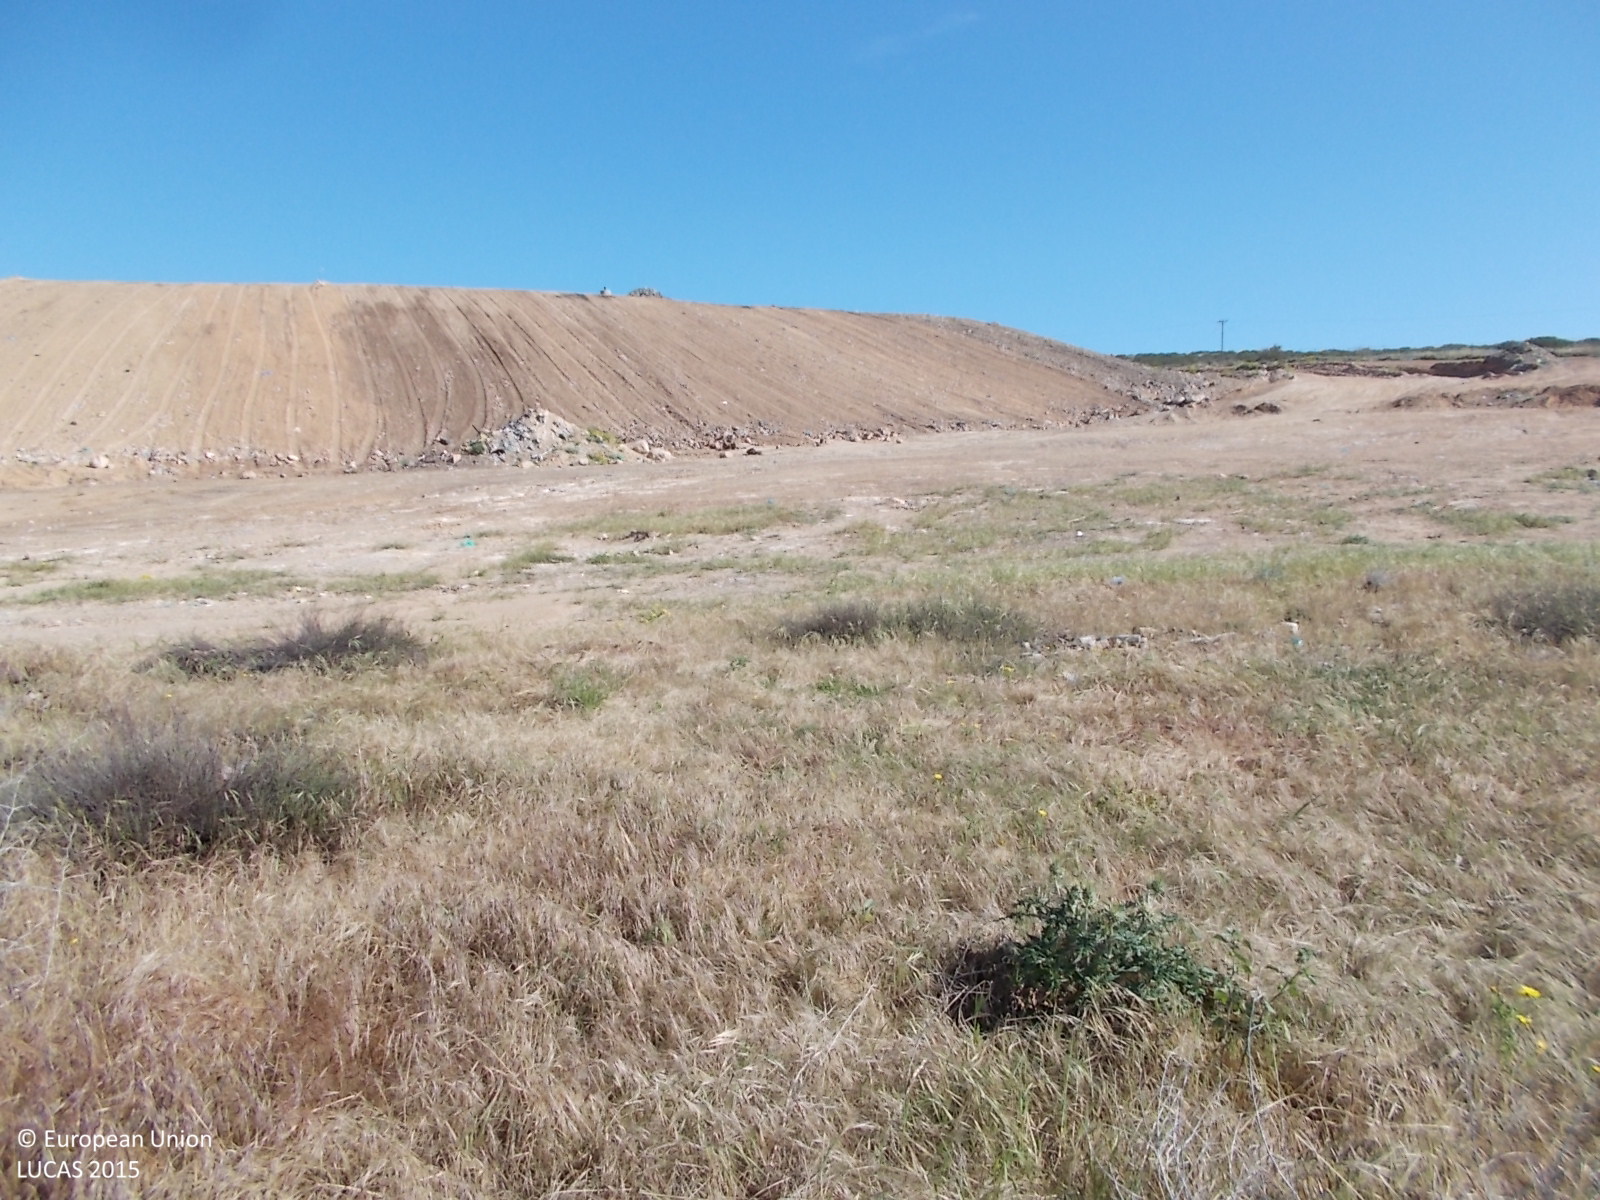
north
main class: Grassland
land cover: Grassland without tree/shrub cover
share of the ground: > 75 %
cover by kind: herbaceous plants 100 %
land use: Semi-natural and natural areas not in use
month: March
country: CY
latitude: 34.9673
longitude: 34.0600
